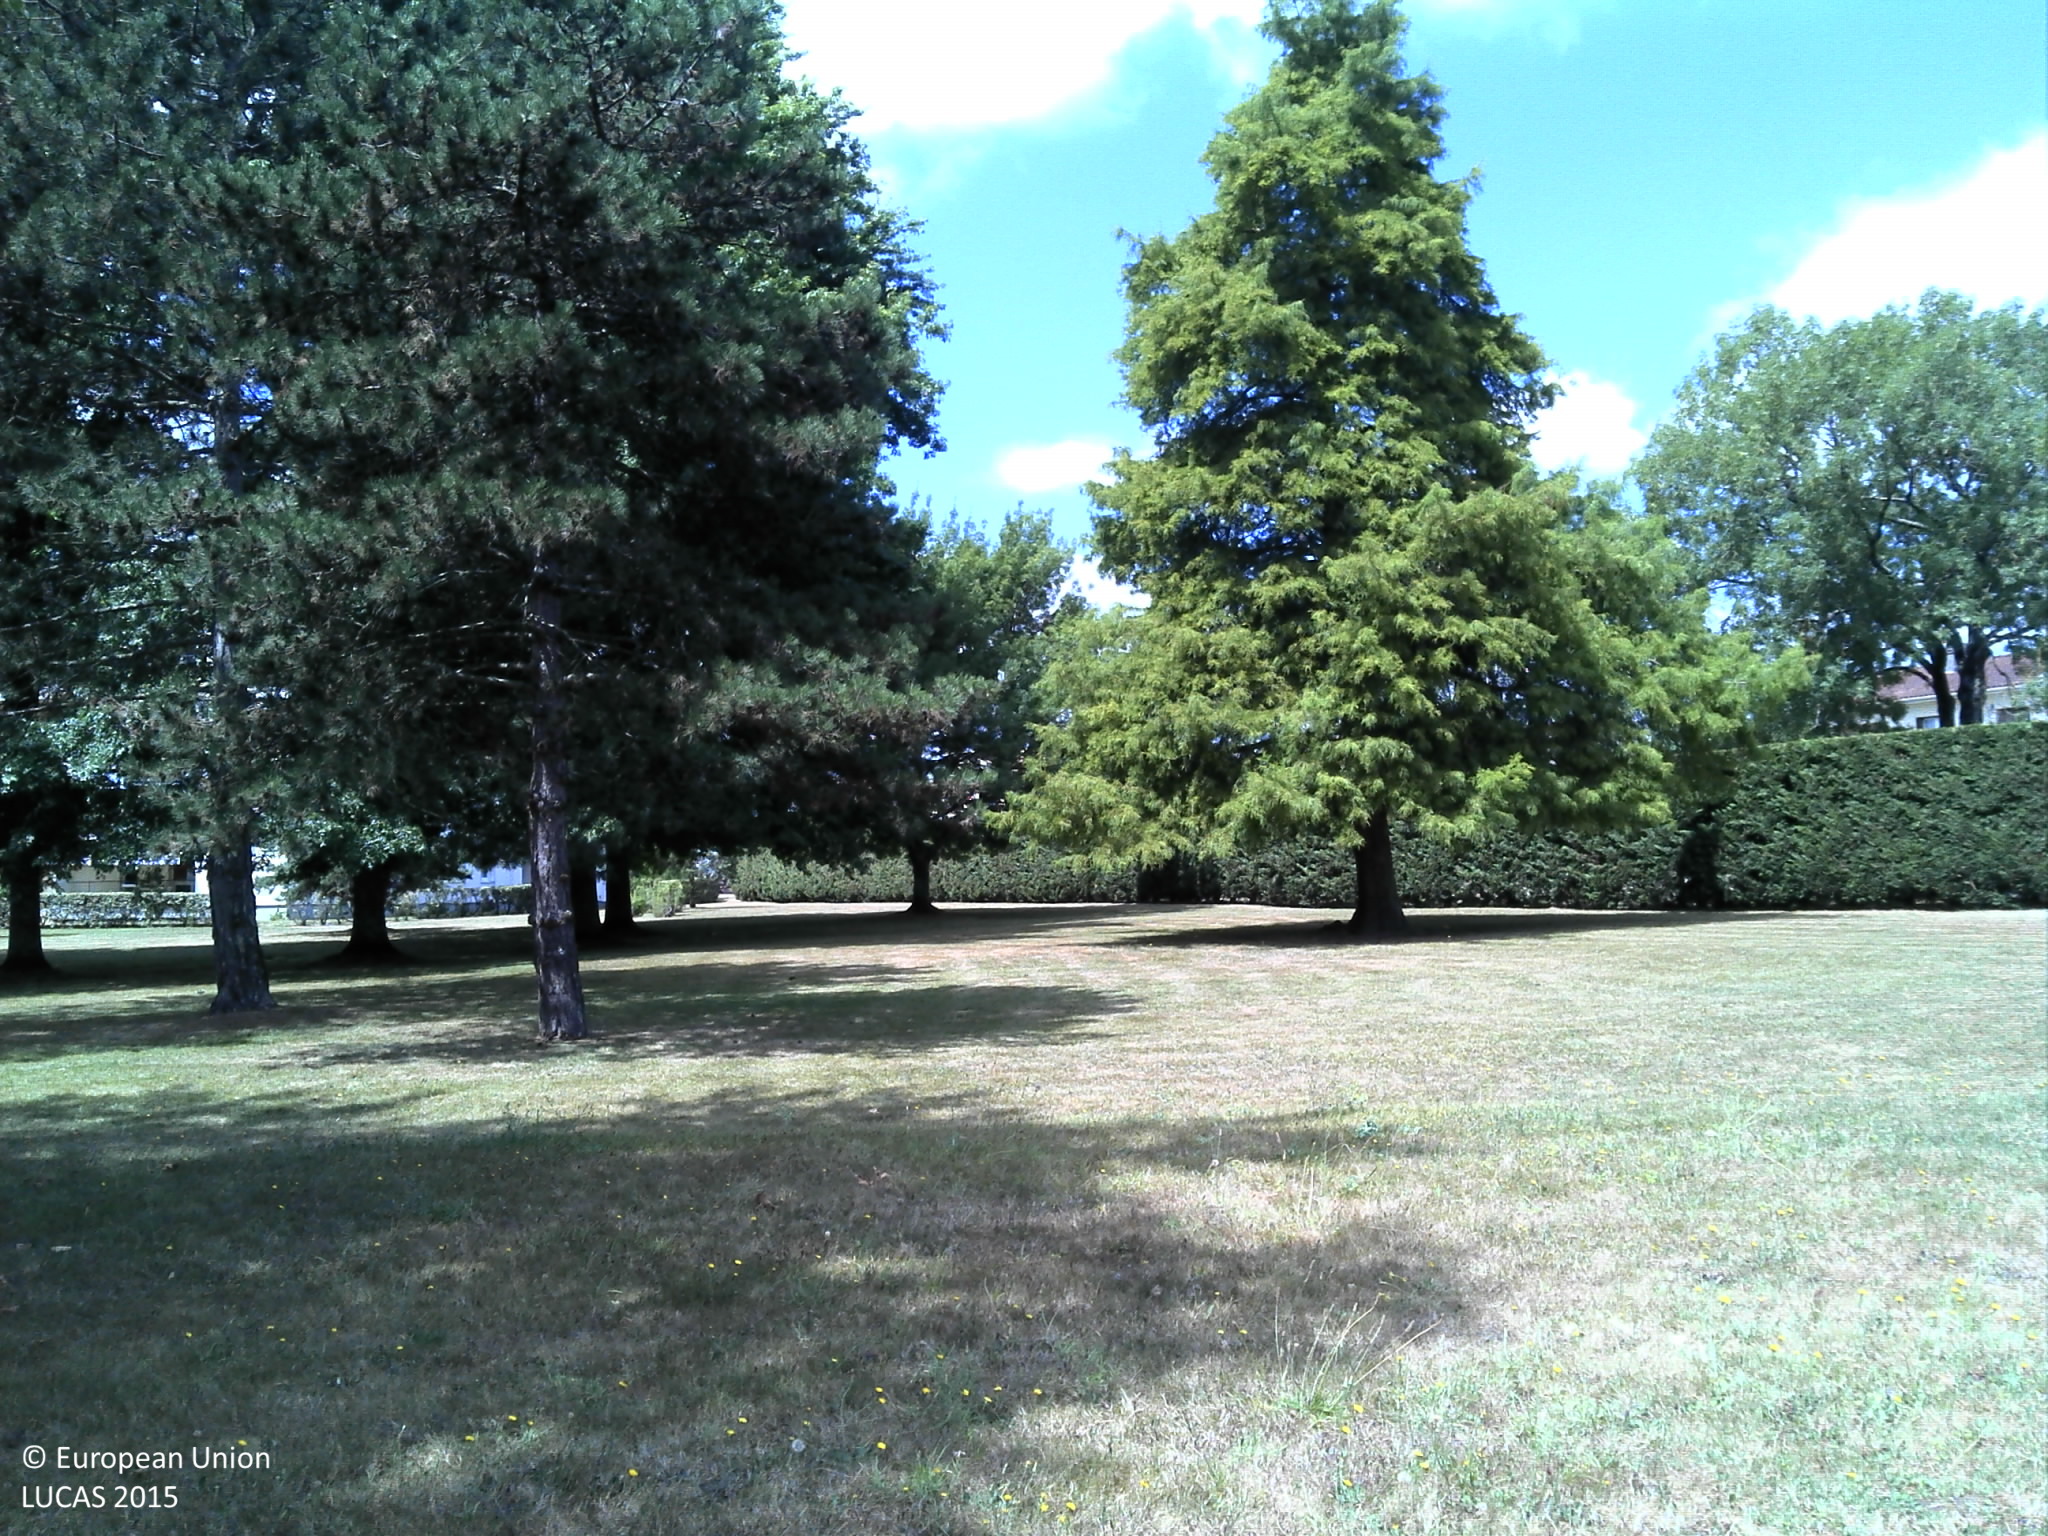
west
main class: Grassland
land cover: Grassland with sparse tree/shrub cover
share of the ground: > 75 %
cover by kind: herbaceous plants 95 %, broadleaved forest trees 5 %
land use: Amenities, museums, leisure
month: July
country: FR
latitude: 44.8565
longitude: -0.6362
